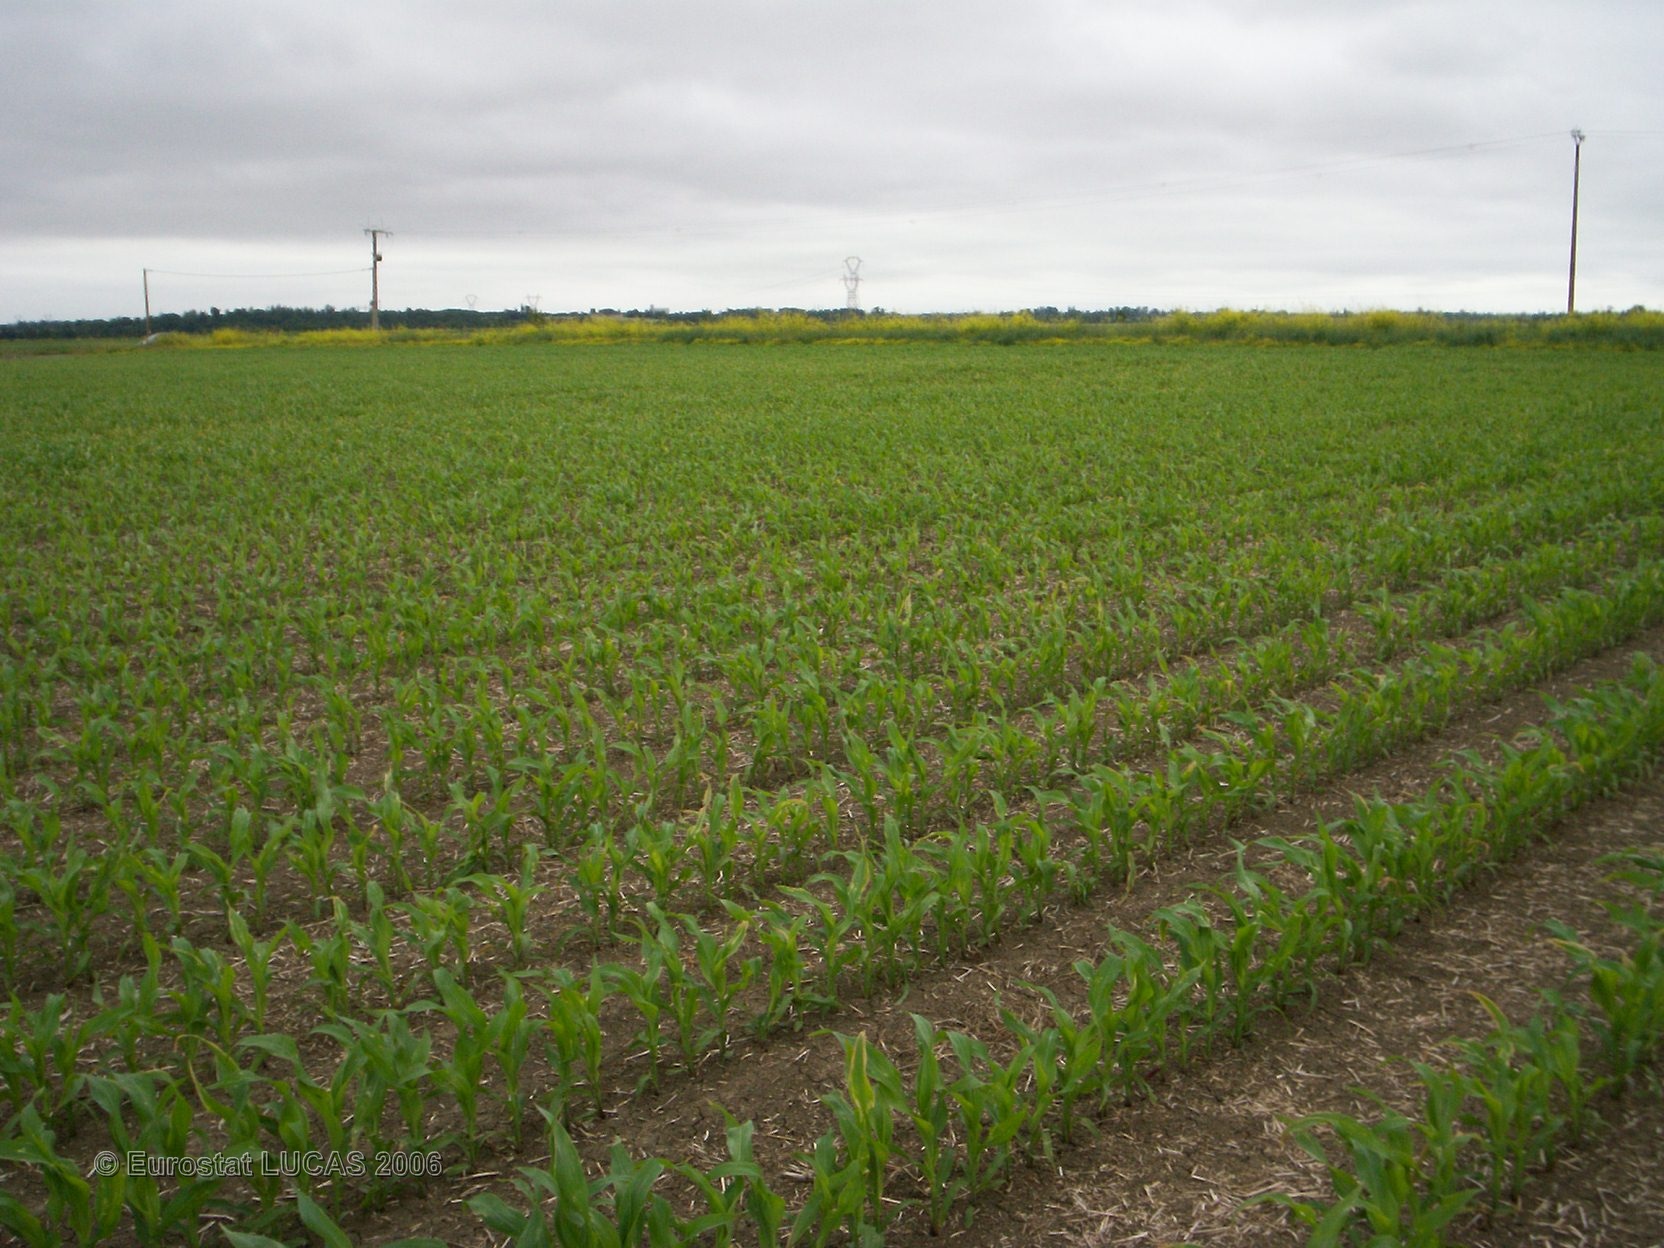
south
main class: Cropland
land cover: Maize
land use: Agriculture (excluding fallow land and kitchen gardens)
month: May
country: FR
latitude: 45.9937
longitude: -0.8862
